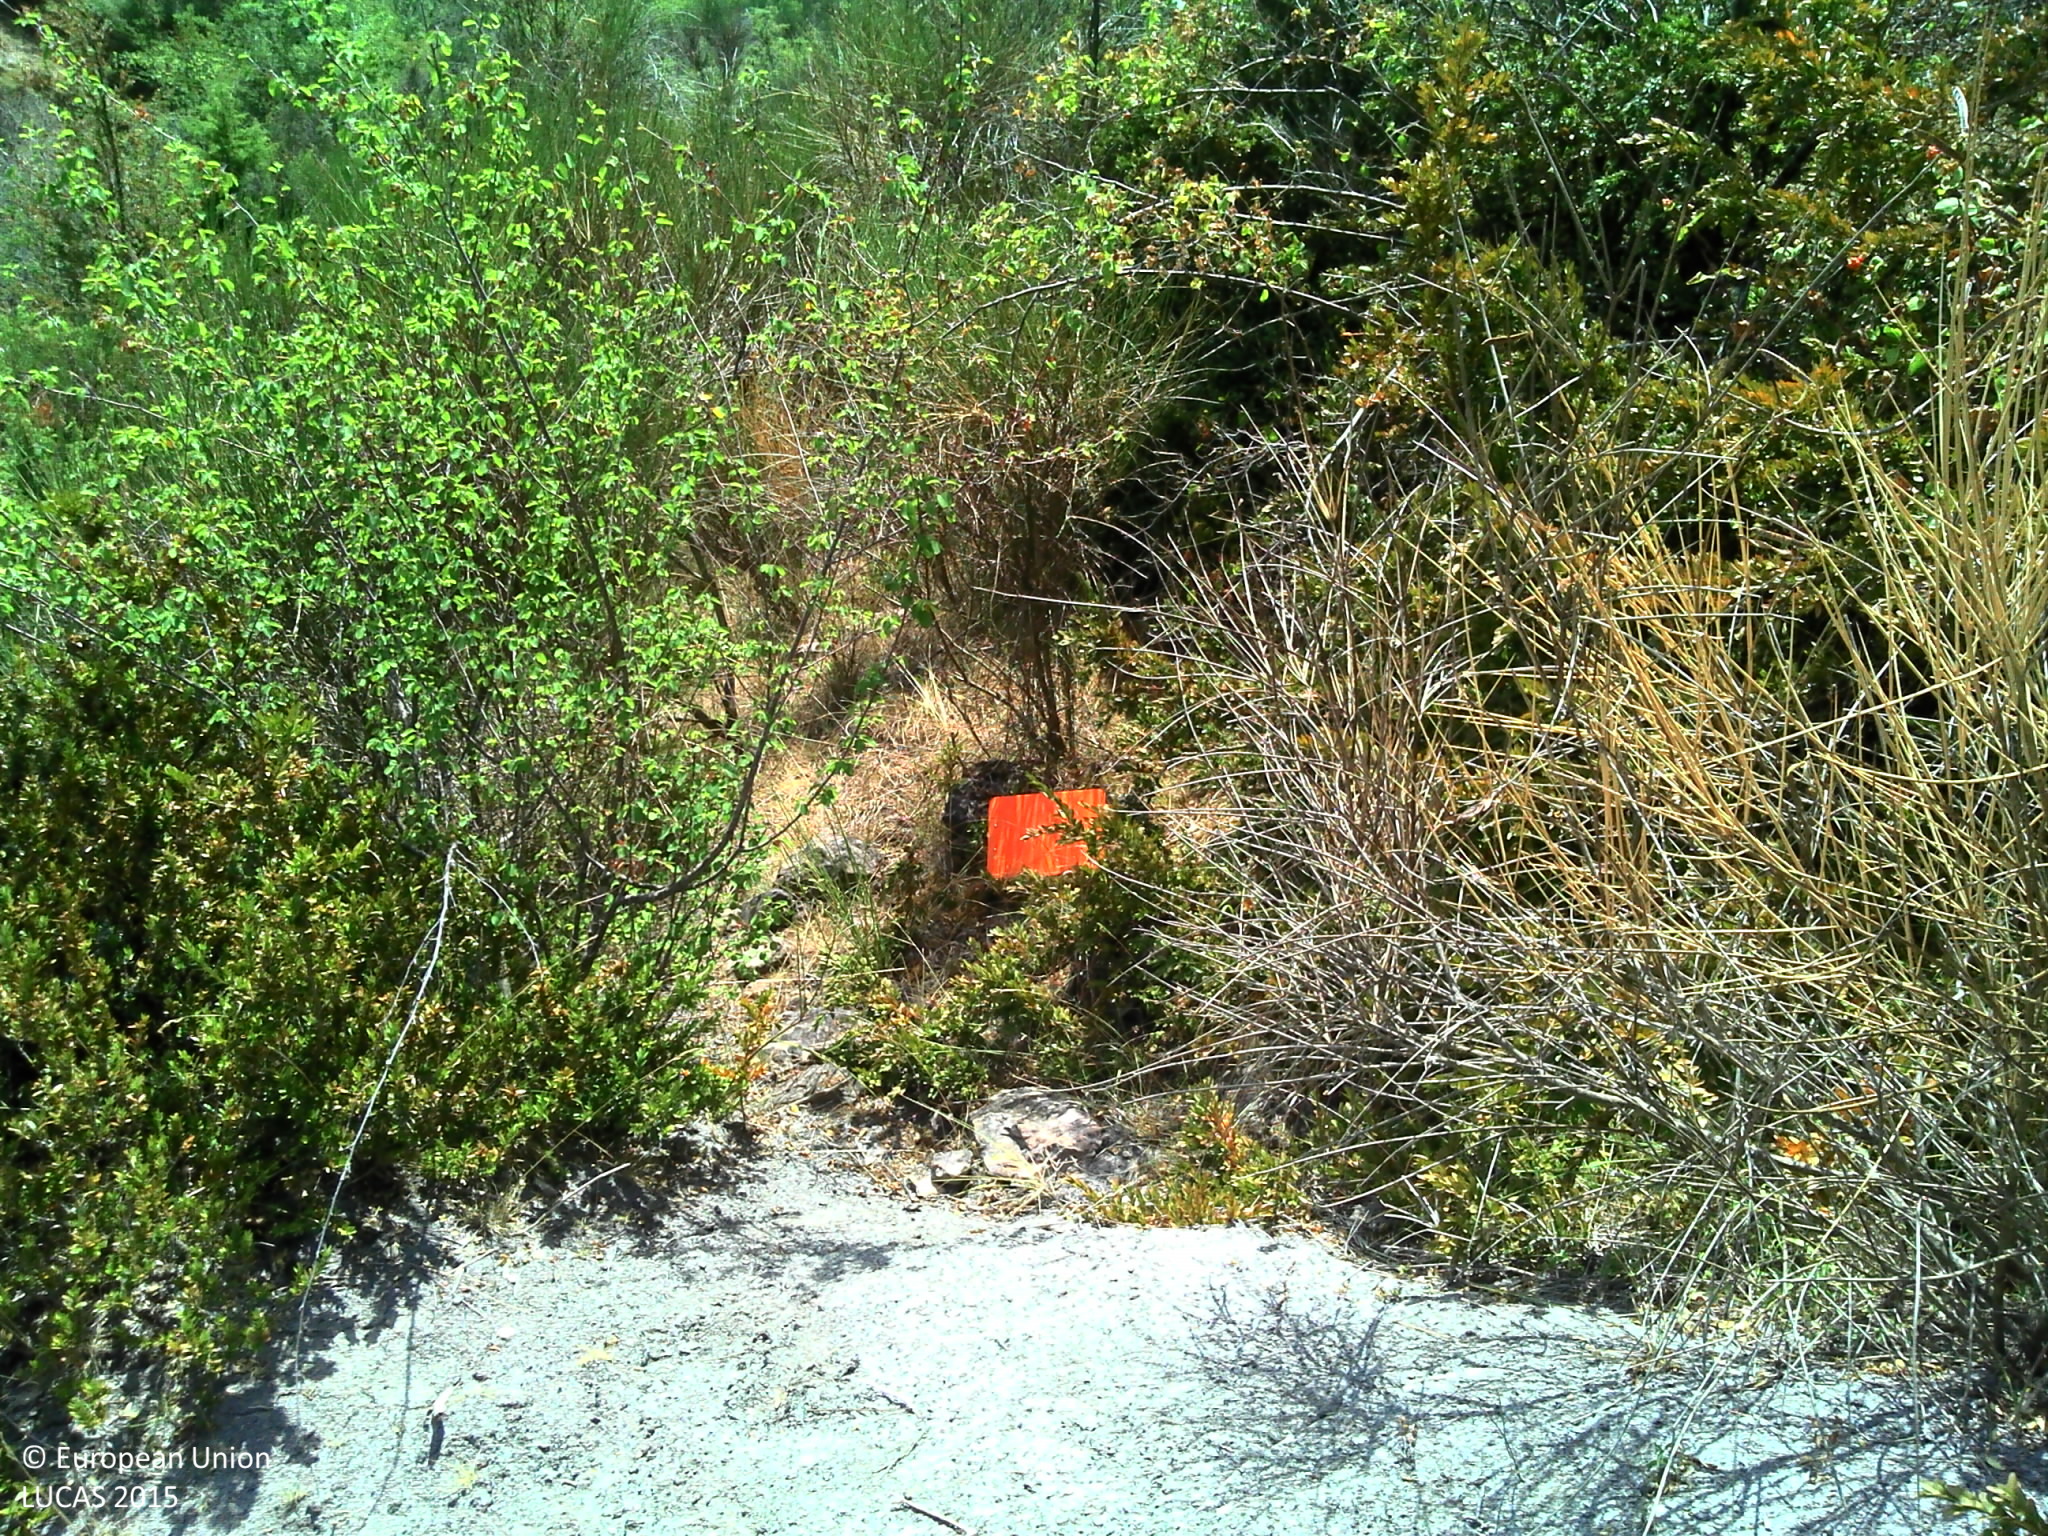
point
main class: Shrubland
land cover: Shrubland without tree cover
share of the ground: > 75 %
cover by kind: shrubs 80 %, unconsolidated bare surface 20 %
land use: Semi-natural and natural areas not in use
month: August
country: FR
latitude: 43.8365
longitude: 3.1794
